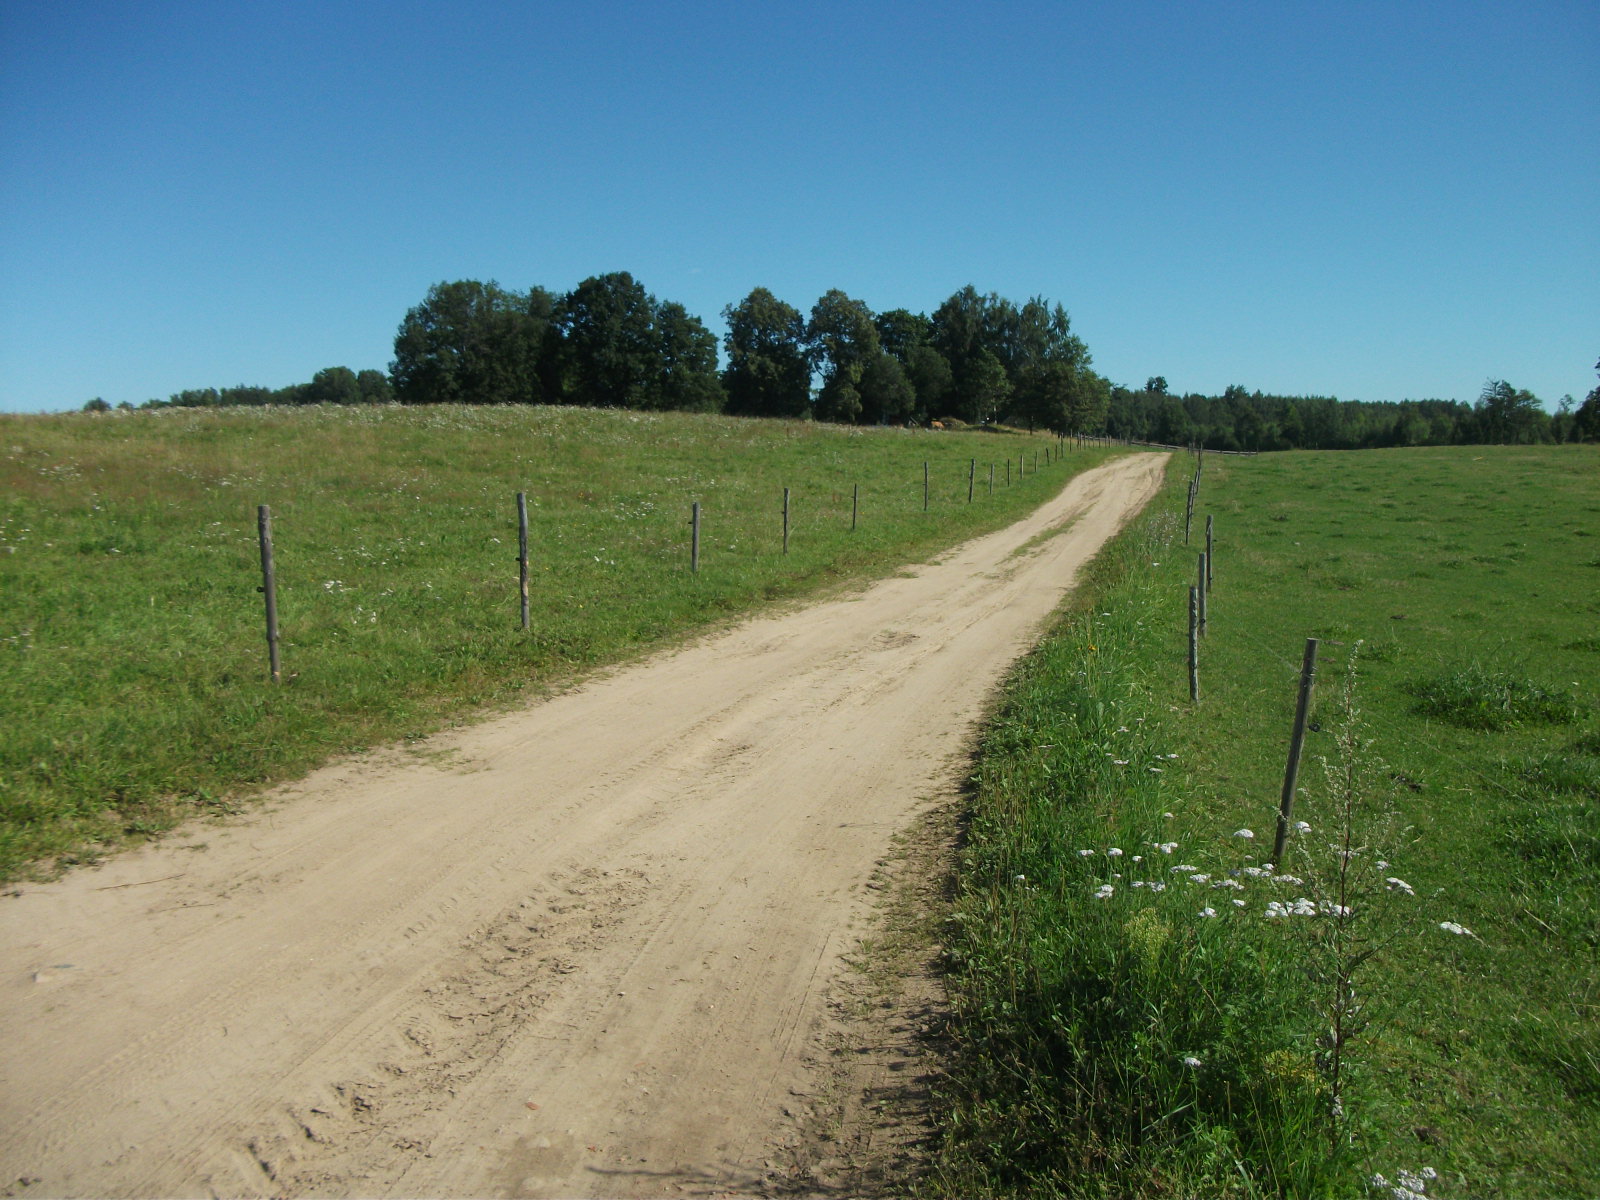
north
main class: Grassland
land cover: Grassland without tree/shrub cover
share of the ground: > 75 %
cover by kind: herbaceous plants 100 %
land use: Agriculture (excluding fallow land and kitchen gardens)
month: August
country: LV
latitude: 57.0347
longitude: 26.4062
